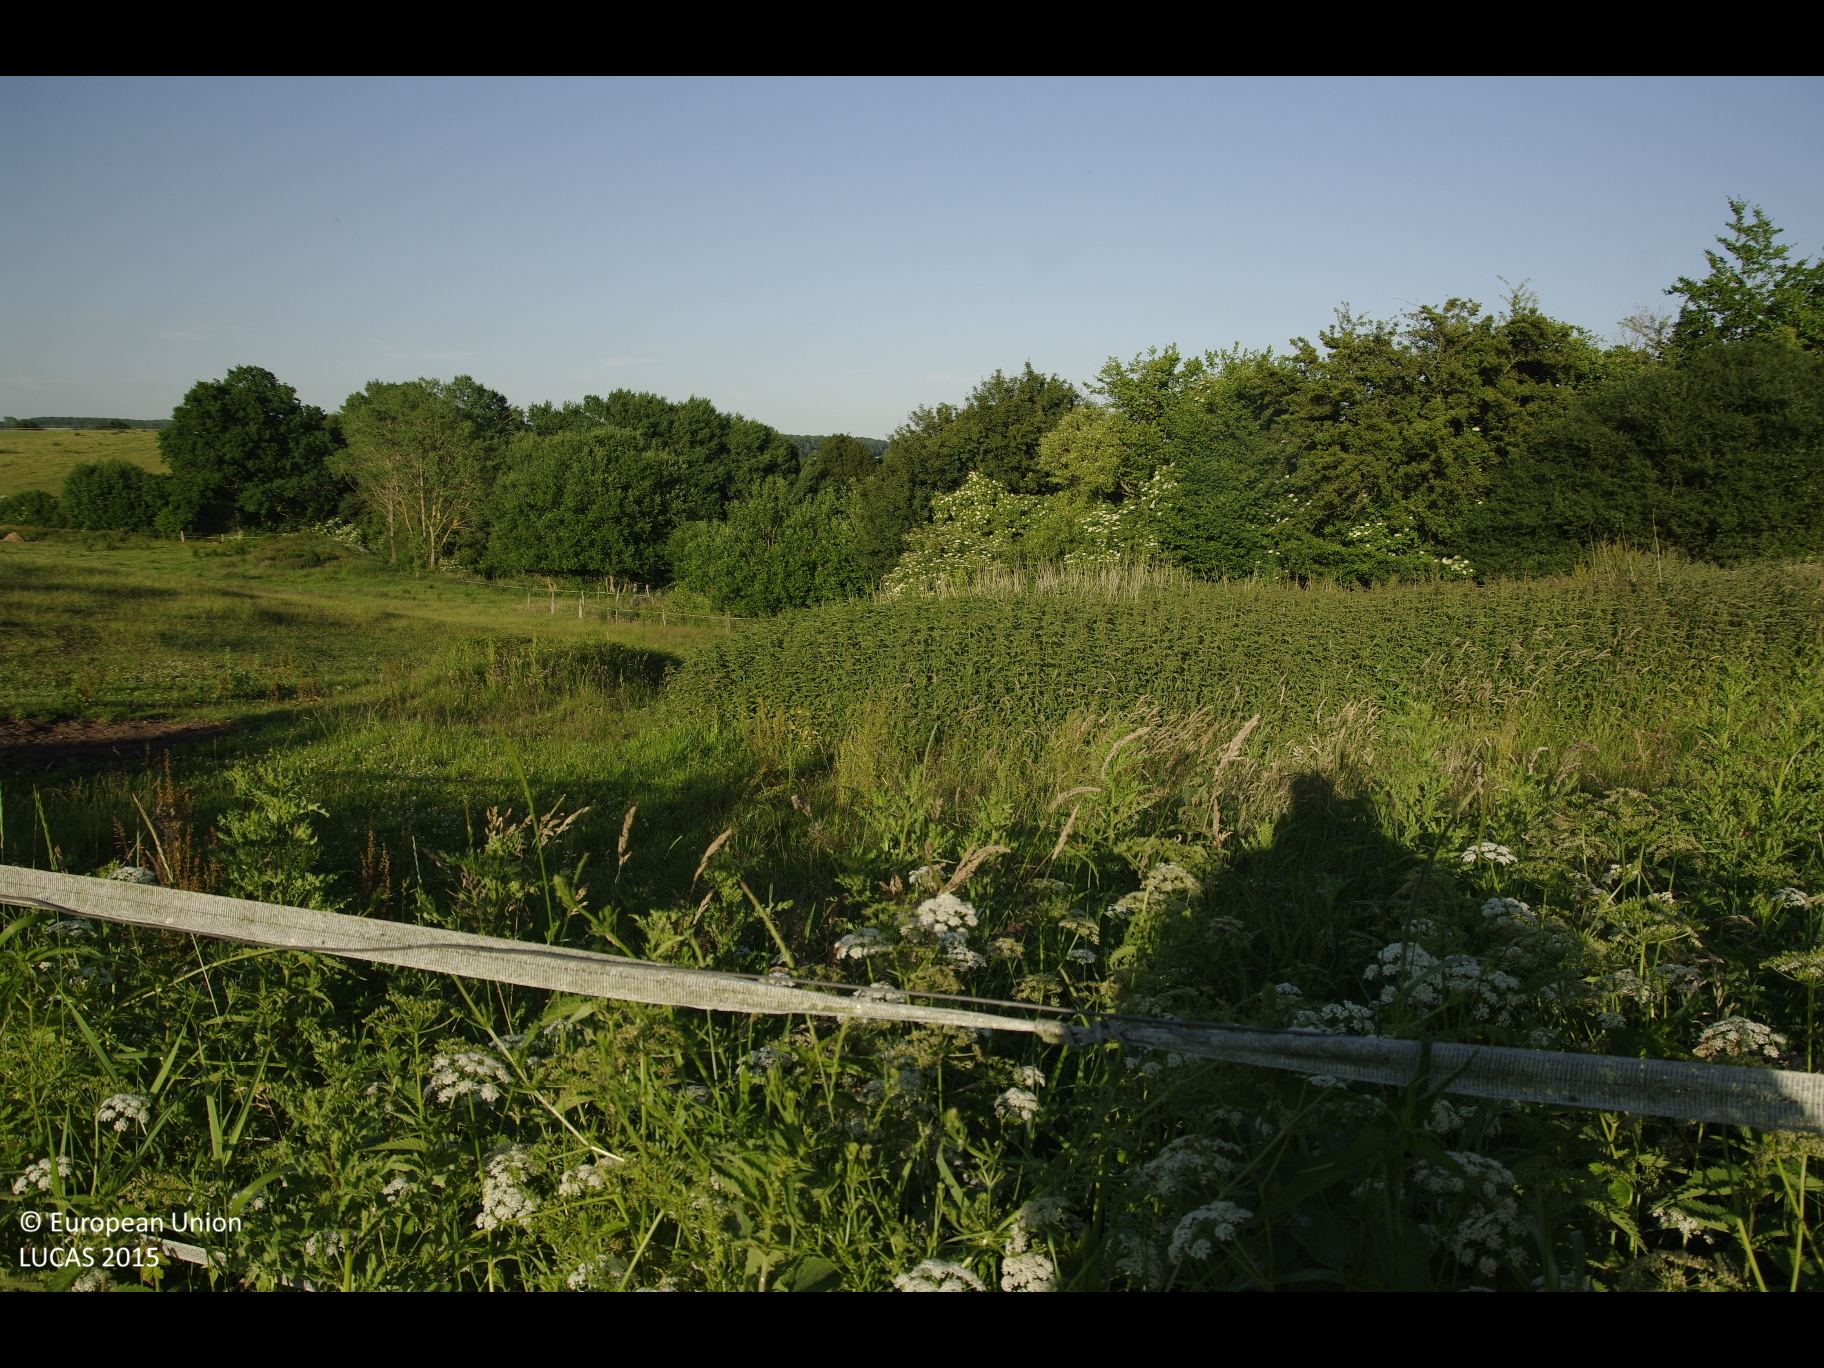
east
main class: Grassland
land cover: Grassland without tree/shrub cover
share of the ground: > 75 %
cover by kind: herbaceous plants 100 %
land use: Agriculture (excluding fallow land and kitchen gardens)
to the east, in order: Grassland without tree/shrub cover; Fences; Abandoned hedges; Grassland without tree/shrub cover; Fences; Grassland without tree/shrub cover
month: June
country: DE
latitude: 53.7059
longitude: 10.6208
